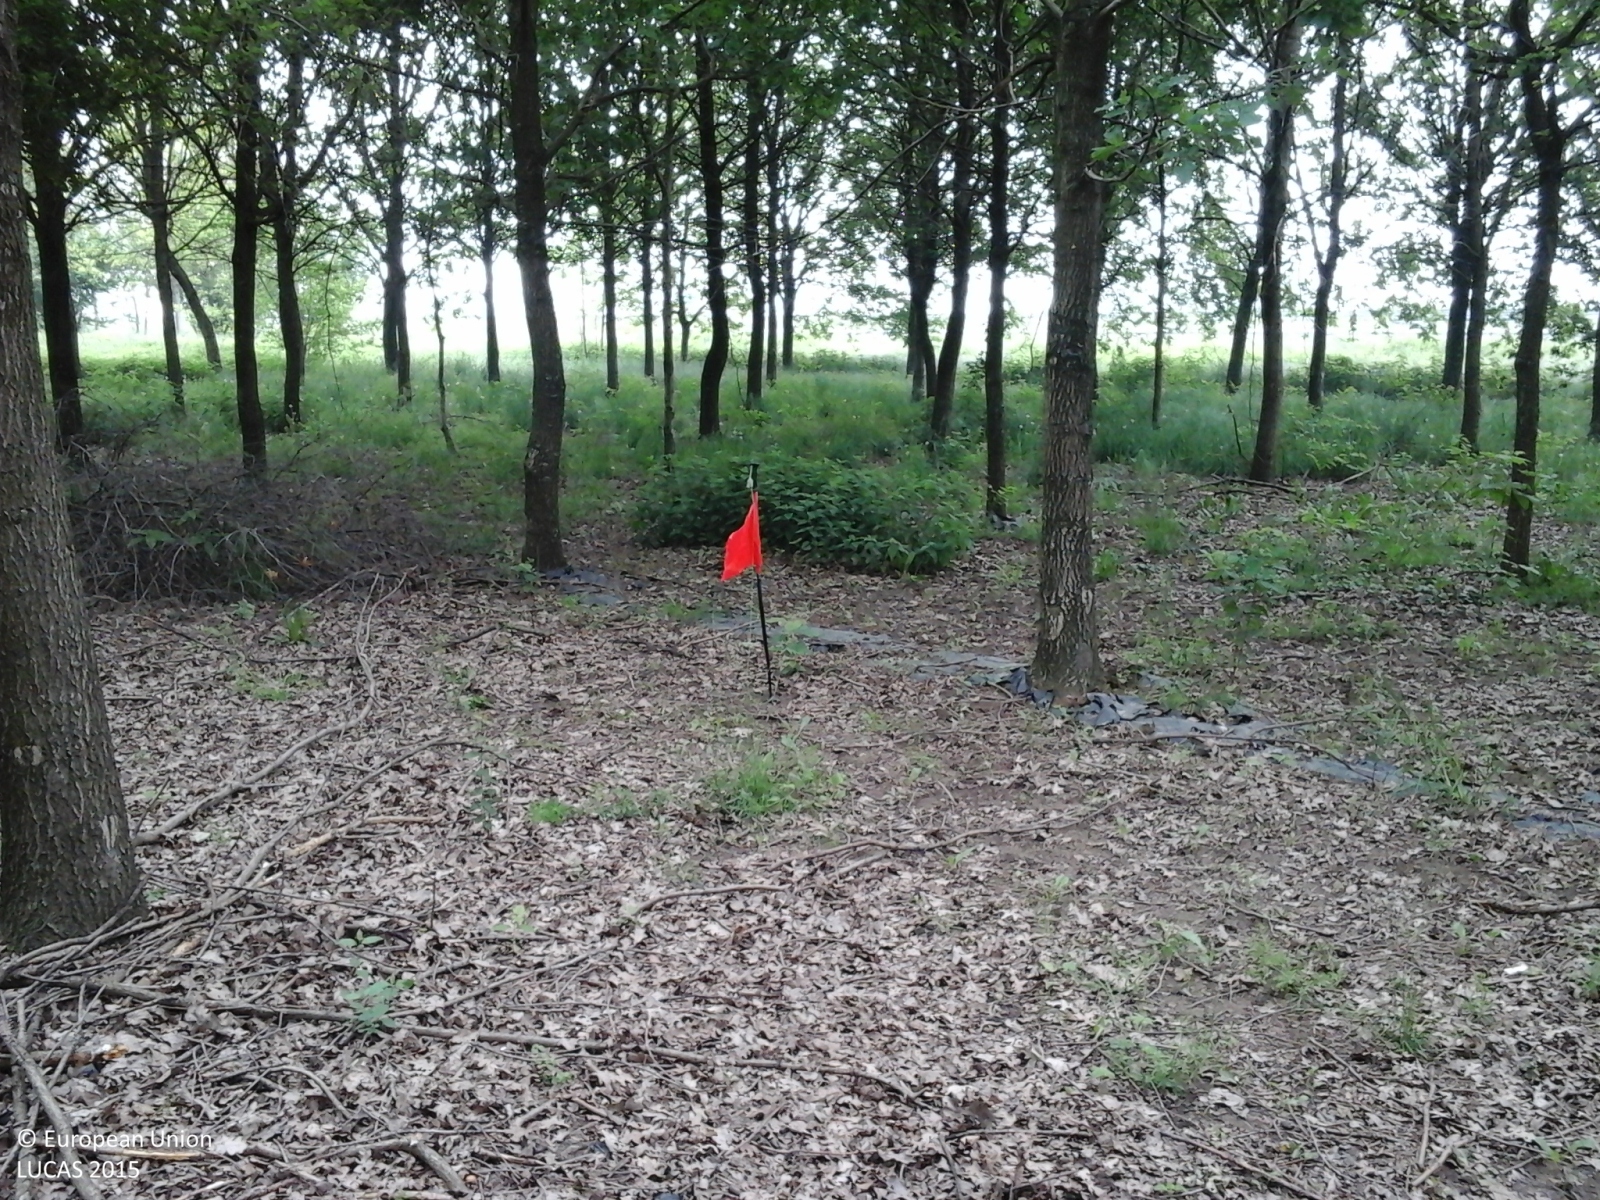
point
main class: Woodland
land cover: Broadleaved woodland
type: mesophytic deciduous forest
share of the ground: > 75 %
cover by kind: broadleaved forest trees 100 %
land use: Forestry
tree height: > 5 m
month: May
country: IT
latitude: 45.1259
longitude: 10.0634
